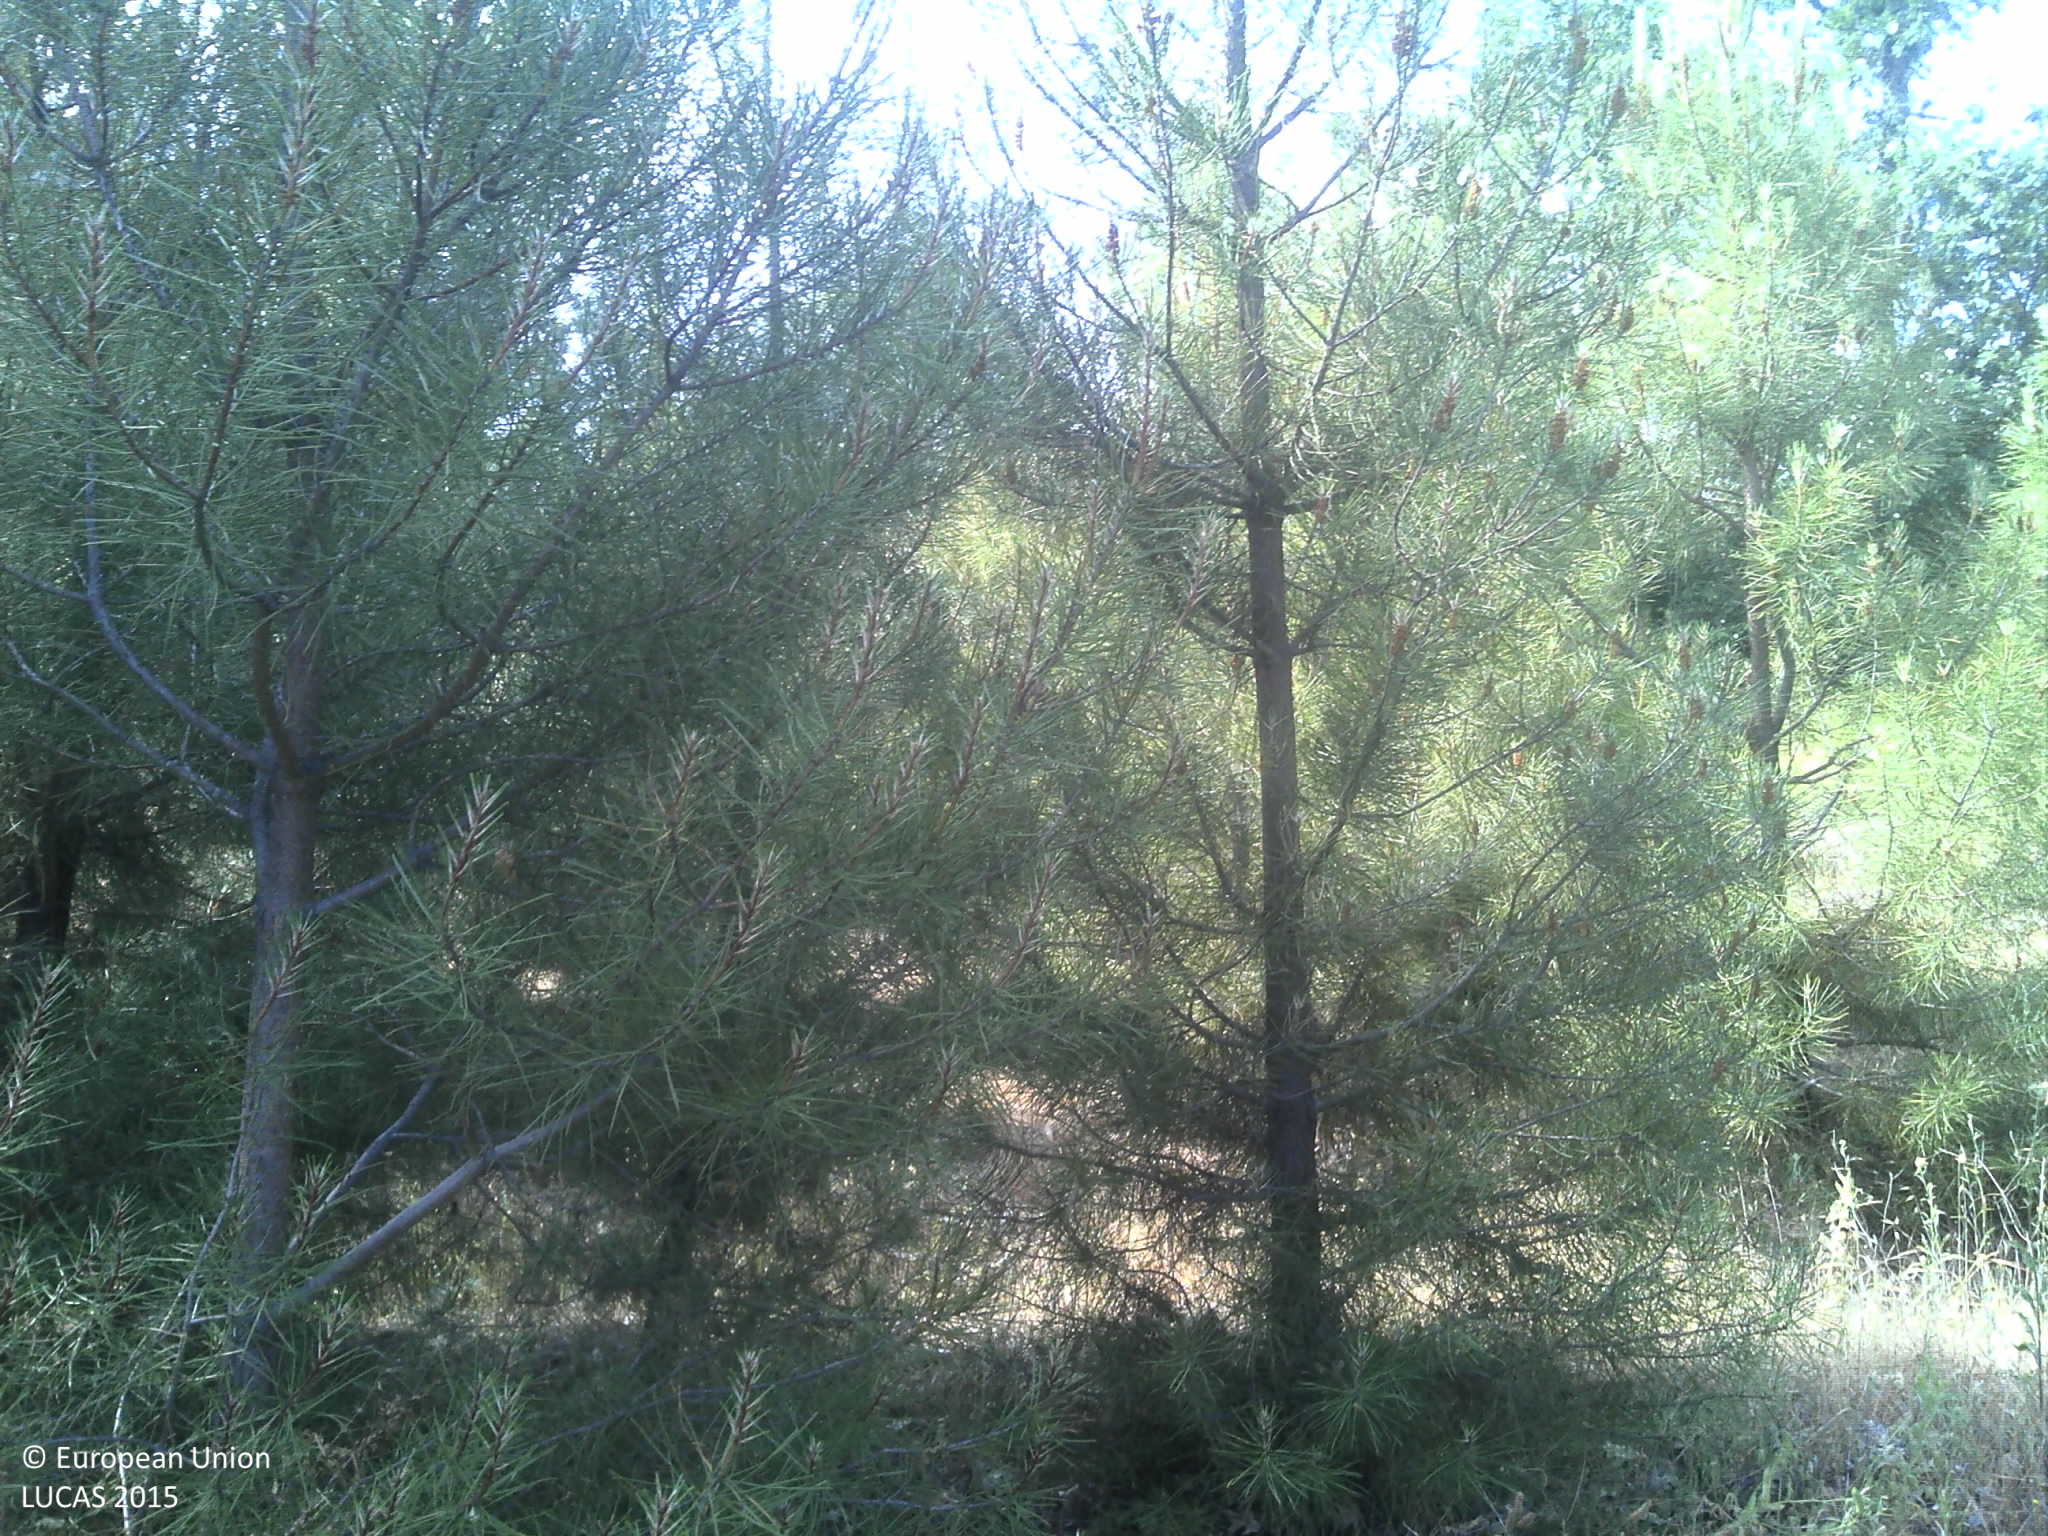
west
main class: Woodland
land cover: Pine dominated coniferous woodland
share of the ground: 50 - 75 %
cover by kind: coniferous forest trees 65 %, unconsolidated bare surface 15 %, shrubs 10 %, herbaceous plants 10 %
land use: Forestry
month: June
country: PT
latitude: 40.4244
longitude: -7.0357
